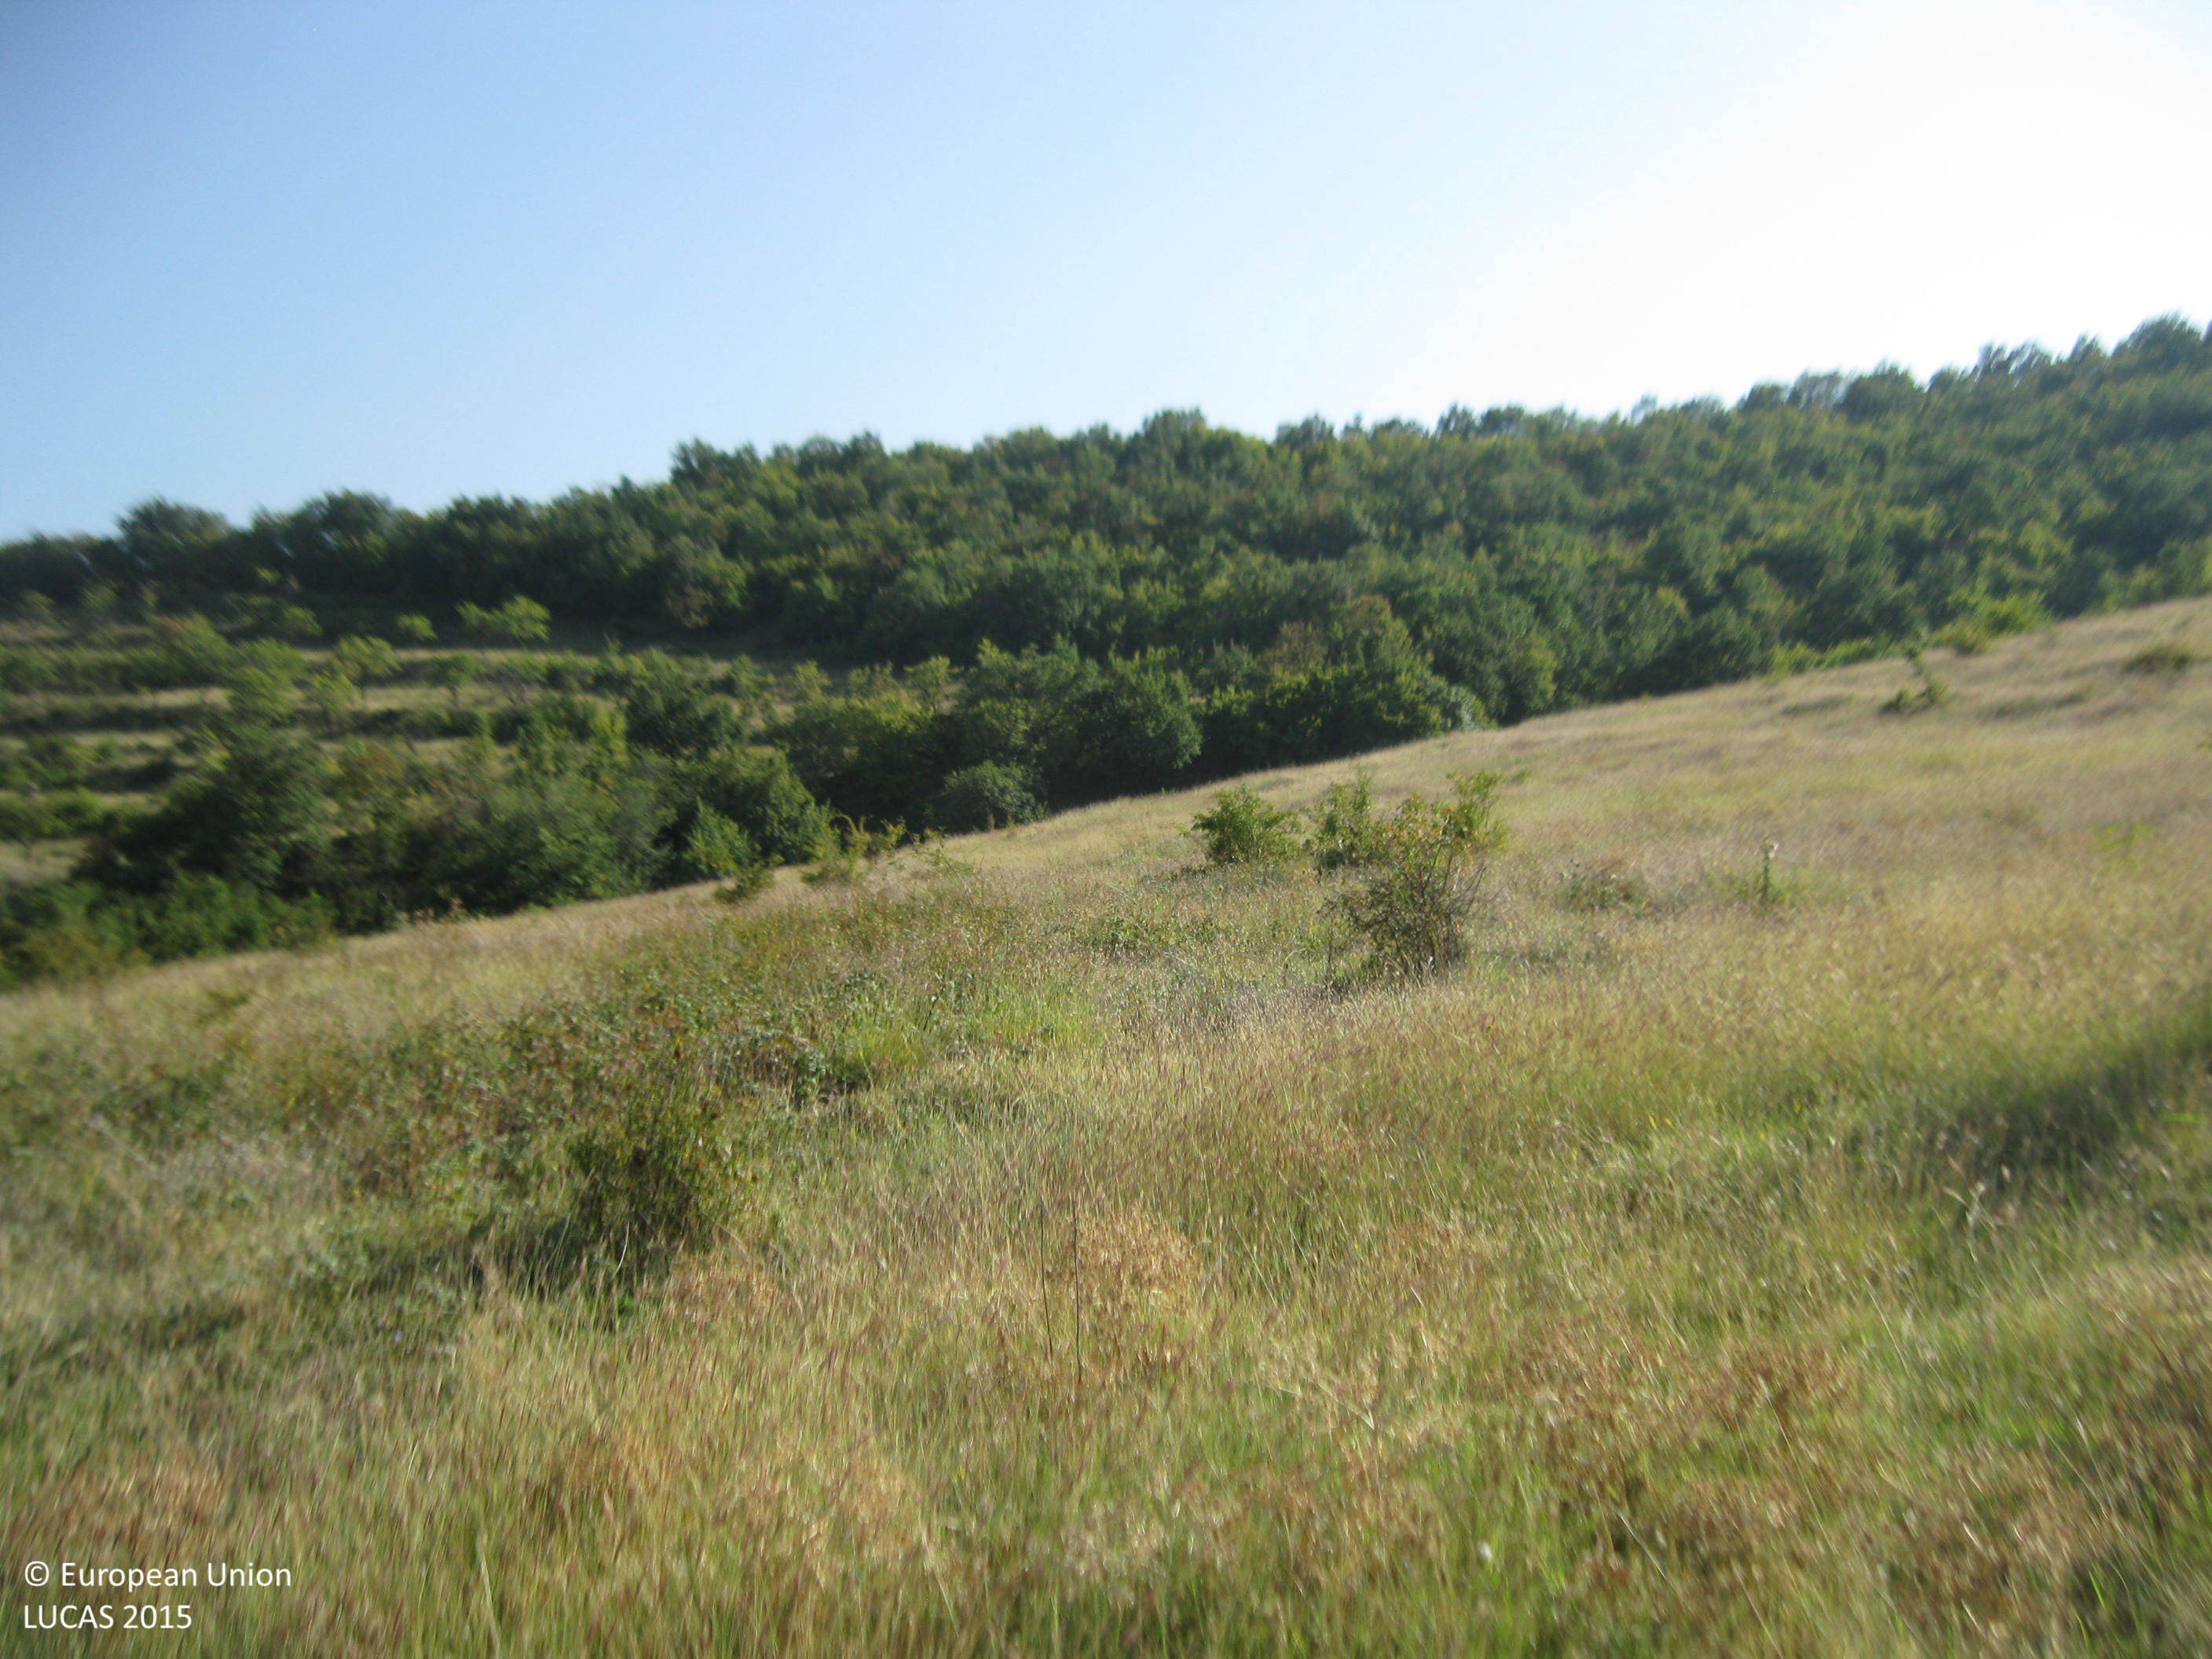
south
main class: Grassland
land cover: Grassland with sparse tree/shrub cover
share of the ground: > 75 %
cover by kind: herbaceous plants 90 %, broadleaved forest trees 5 %, shrubs 5 %
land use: Agriculture (excluding fallow land and kitchen gardens)
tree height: < 5 m
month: September
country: BG
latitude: 42.0787
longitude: 24.6385
